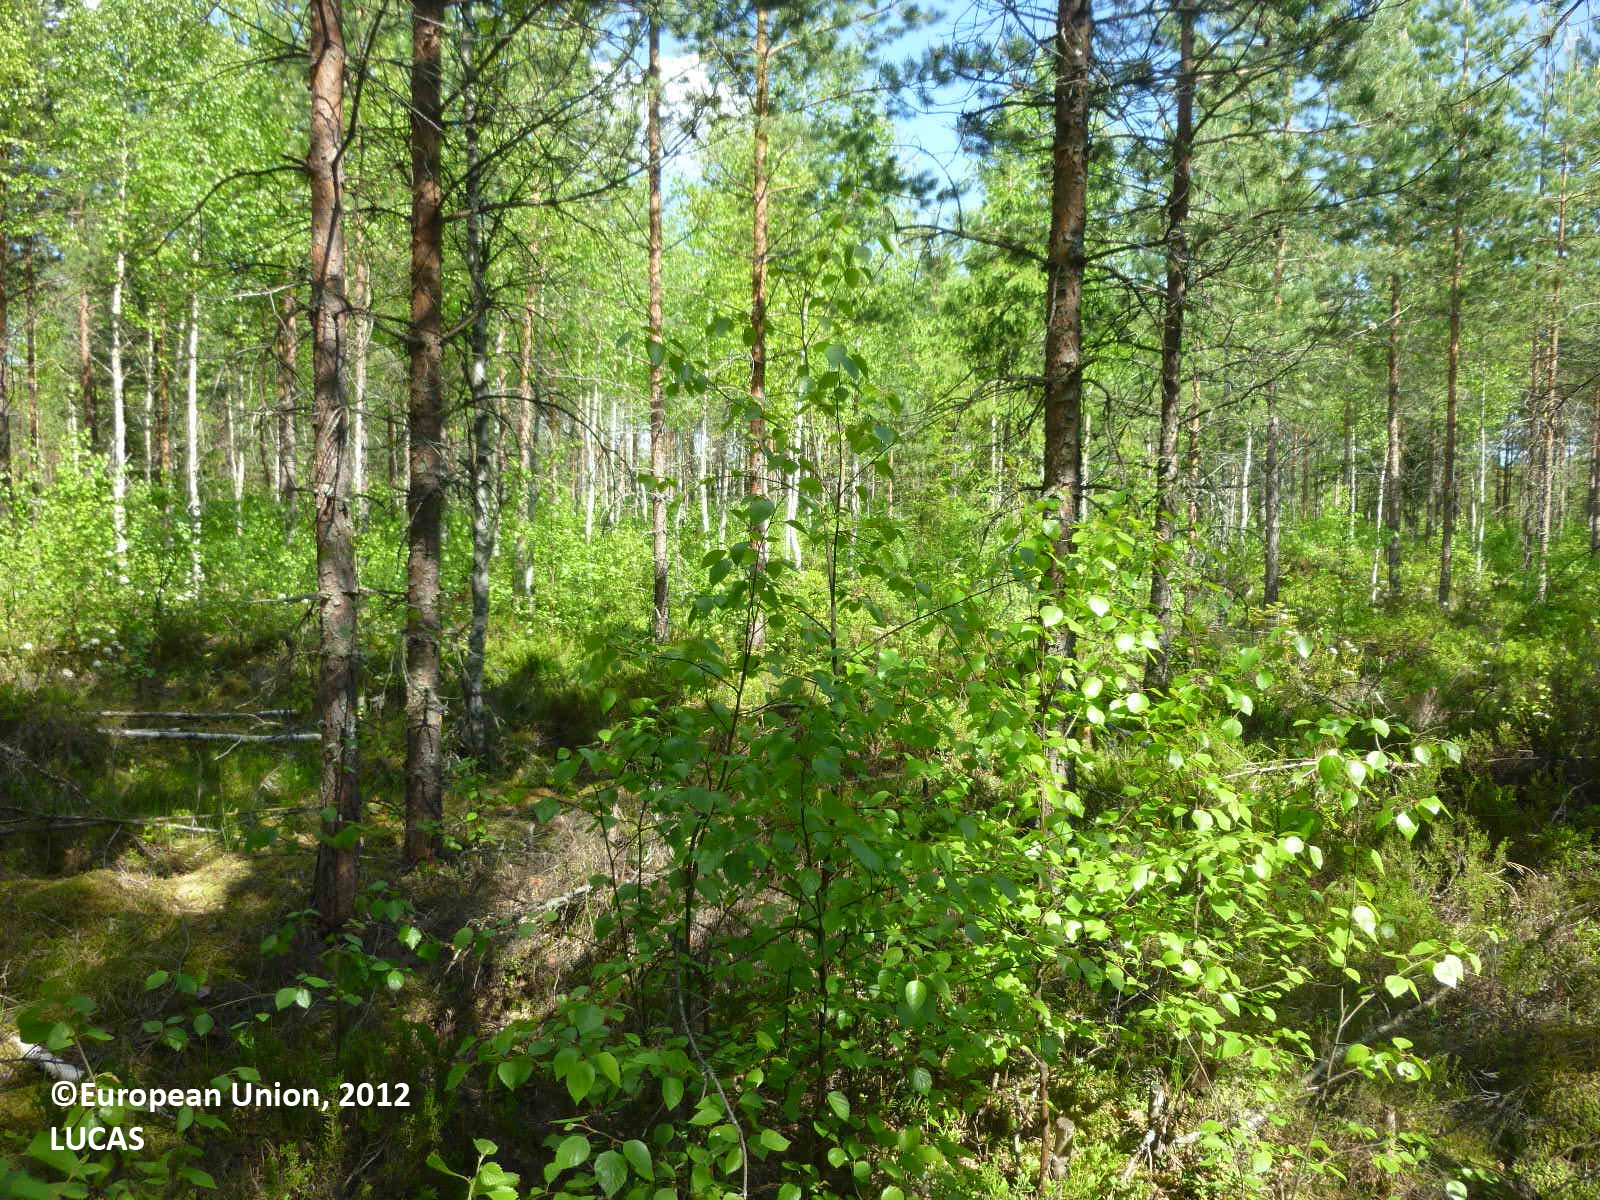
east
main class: Woodland
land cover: Pine dominated mixed woodland
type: boreal forest
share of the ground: 50 - 75 %
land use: Forestry
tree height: > 5 m
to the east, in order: Pine dominated mixed woodland; Pine dominated coniferous woodland; Ditches and canals; Pine dominated coniferous woodland; Ditches and canals; Grassland without tree/shrub cover; Paved roads, cycling and walking lanes; Abandoned hedges; Other bare soil
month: June
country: FI
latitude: 61.4442
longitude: 22.7637
